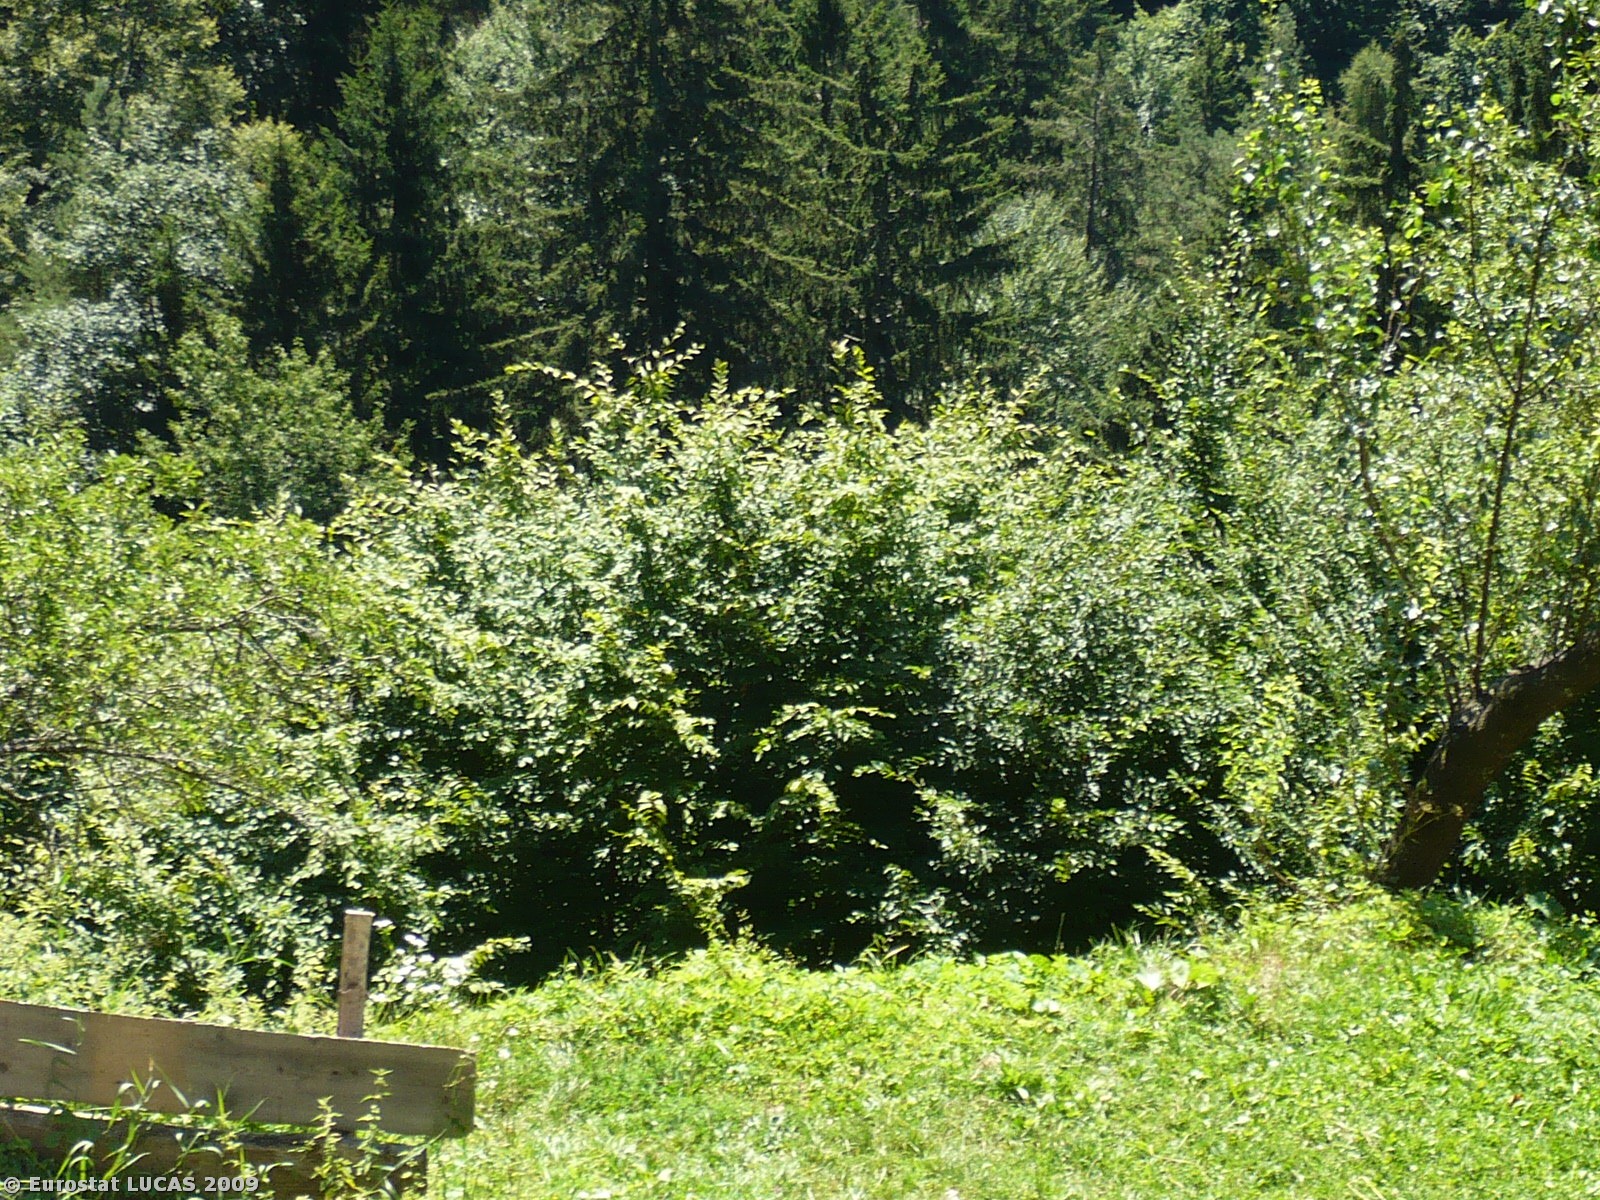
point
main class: Shrubland
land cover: Shrubland with sparse tree cover
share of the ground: > 75 %
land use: Unused
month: July
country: SI
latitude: 46.6149
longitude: 15.3393
